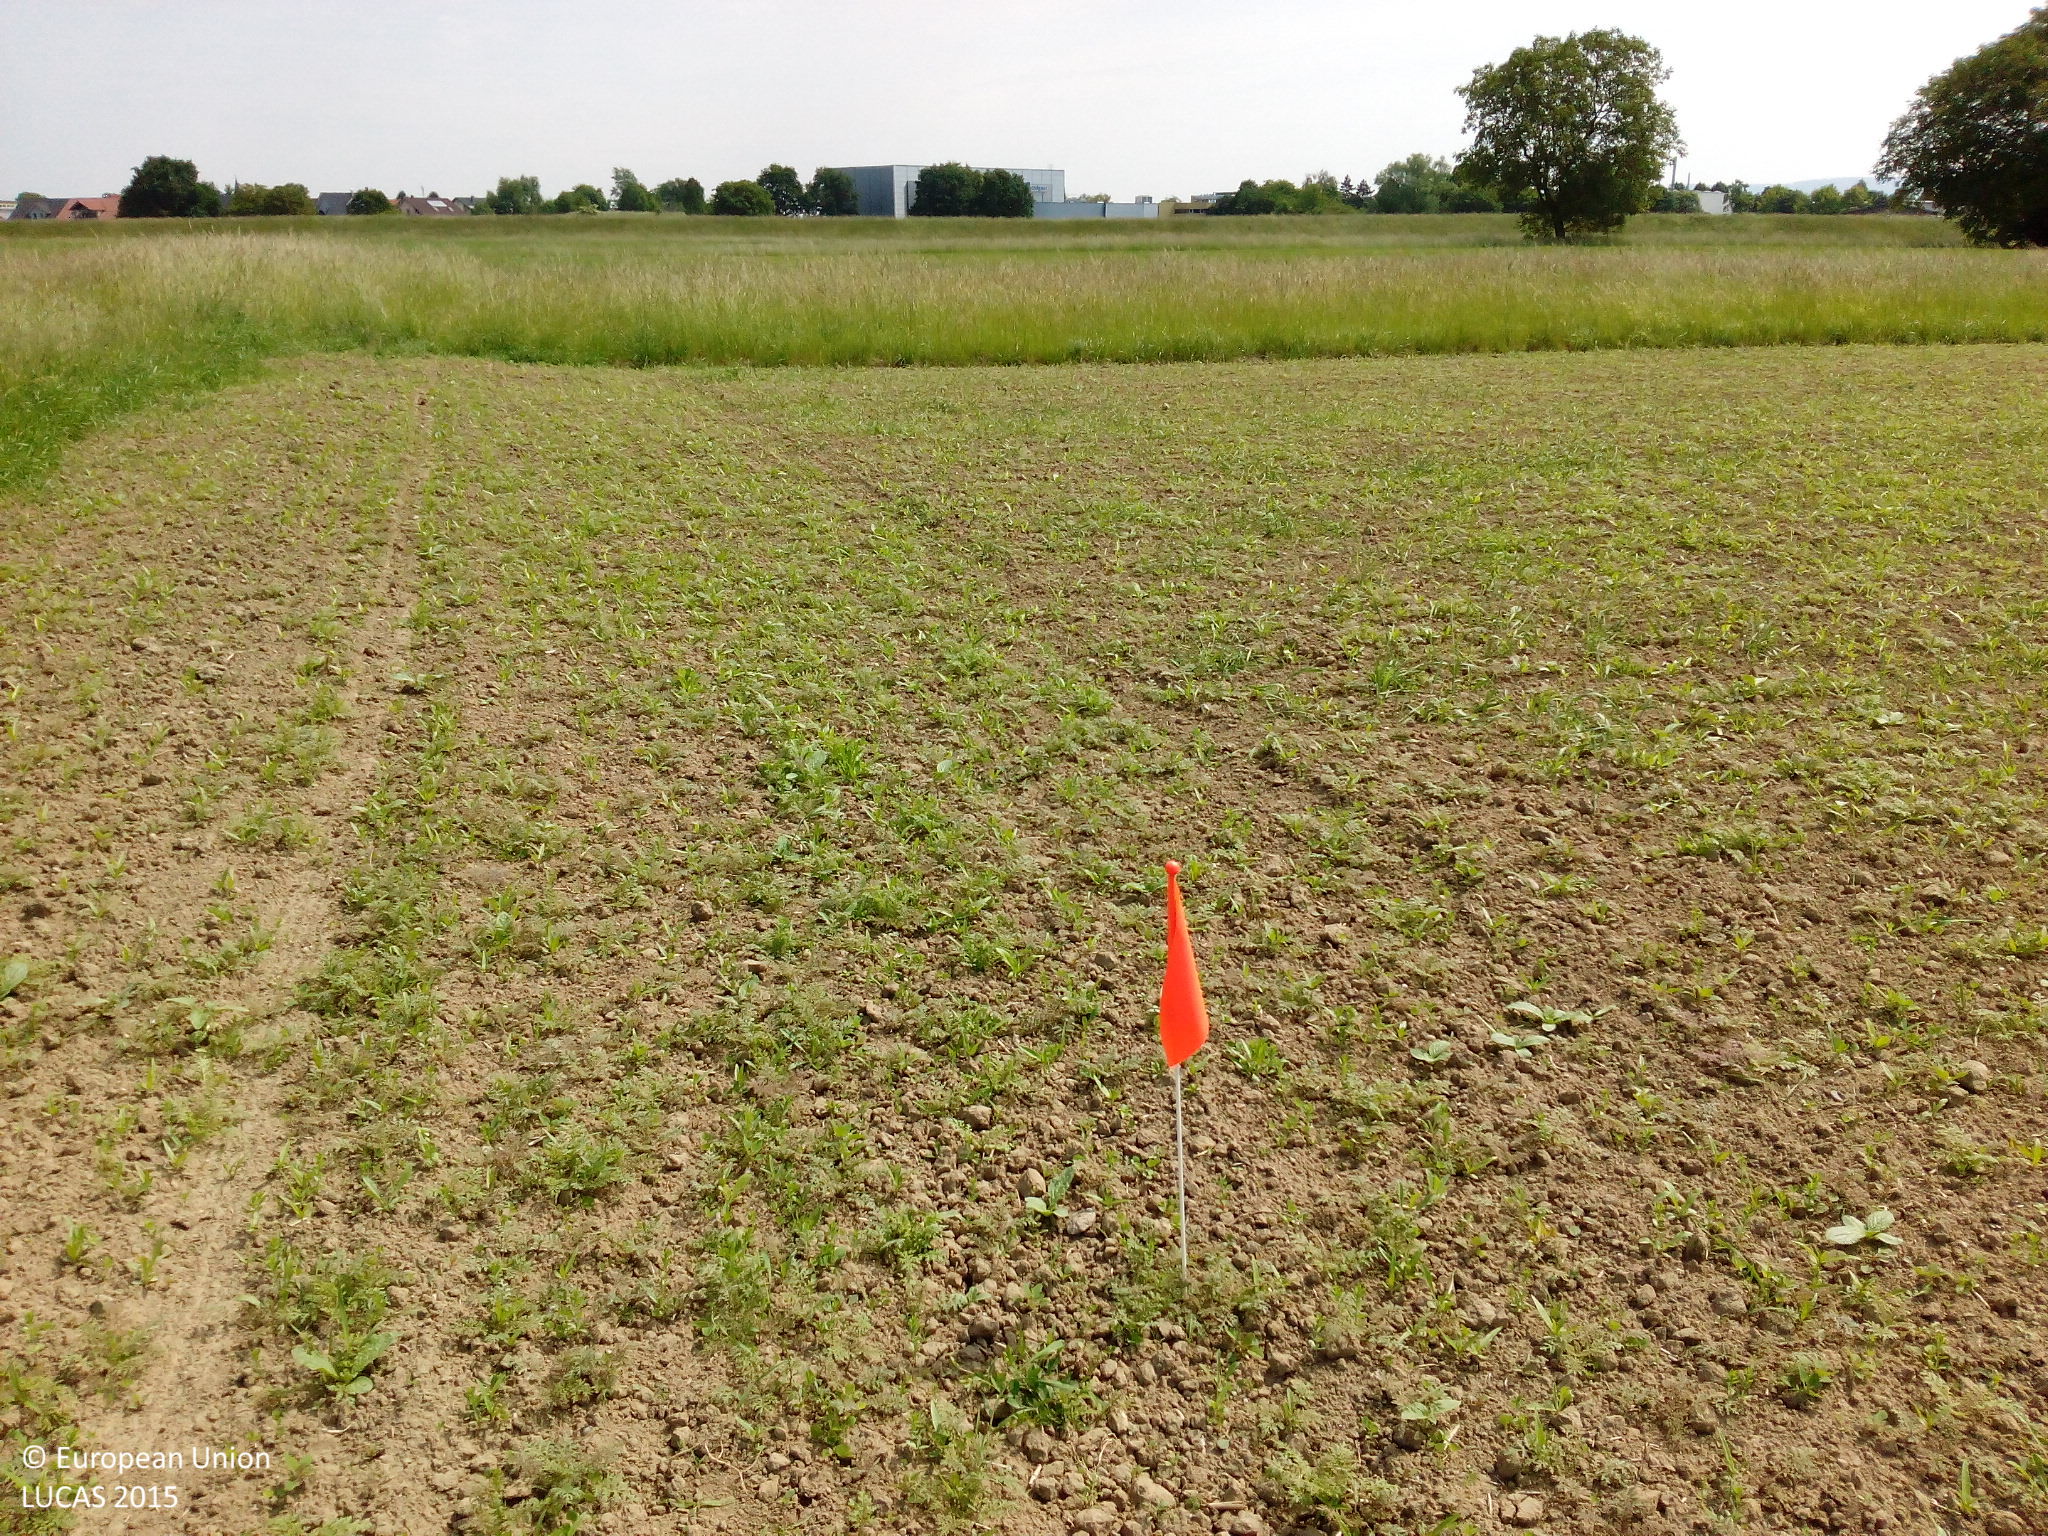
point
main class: Cropland
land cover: Other leguminous and mixtures for fodder
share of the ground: < 10 %
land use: Agriculture (excluding fallow land and kitchen gardens)
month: May
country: DE
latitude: 48.8925
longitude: 8.1866
